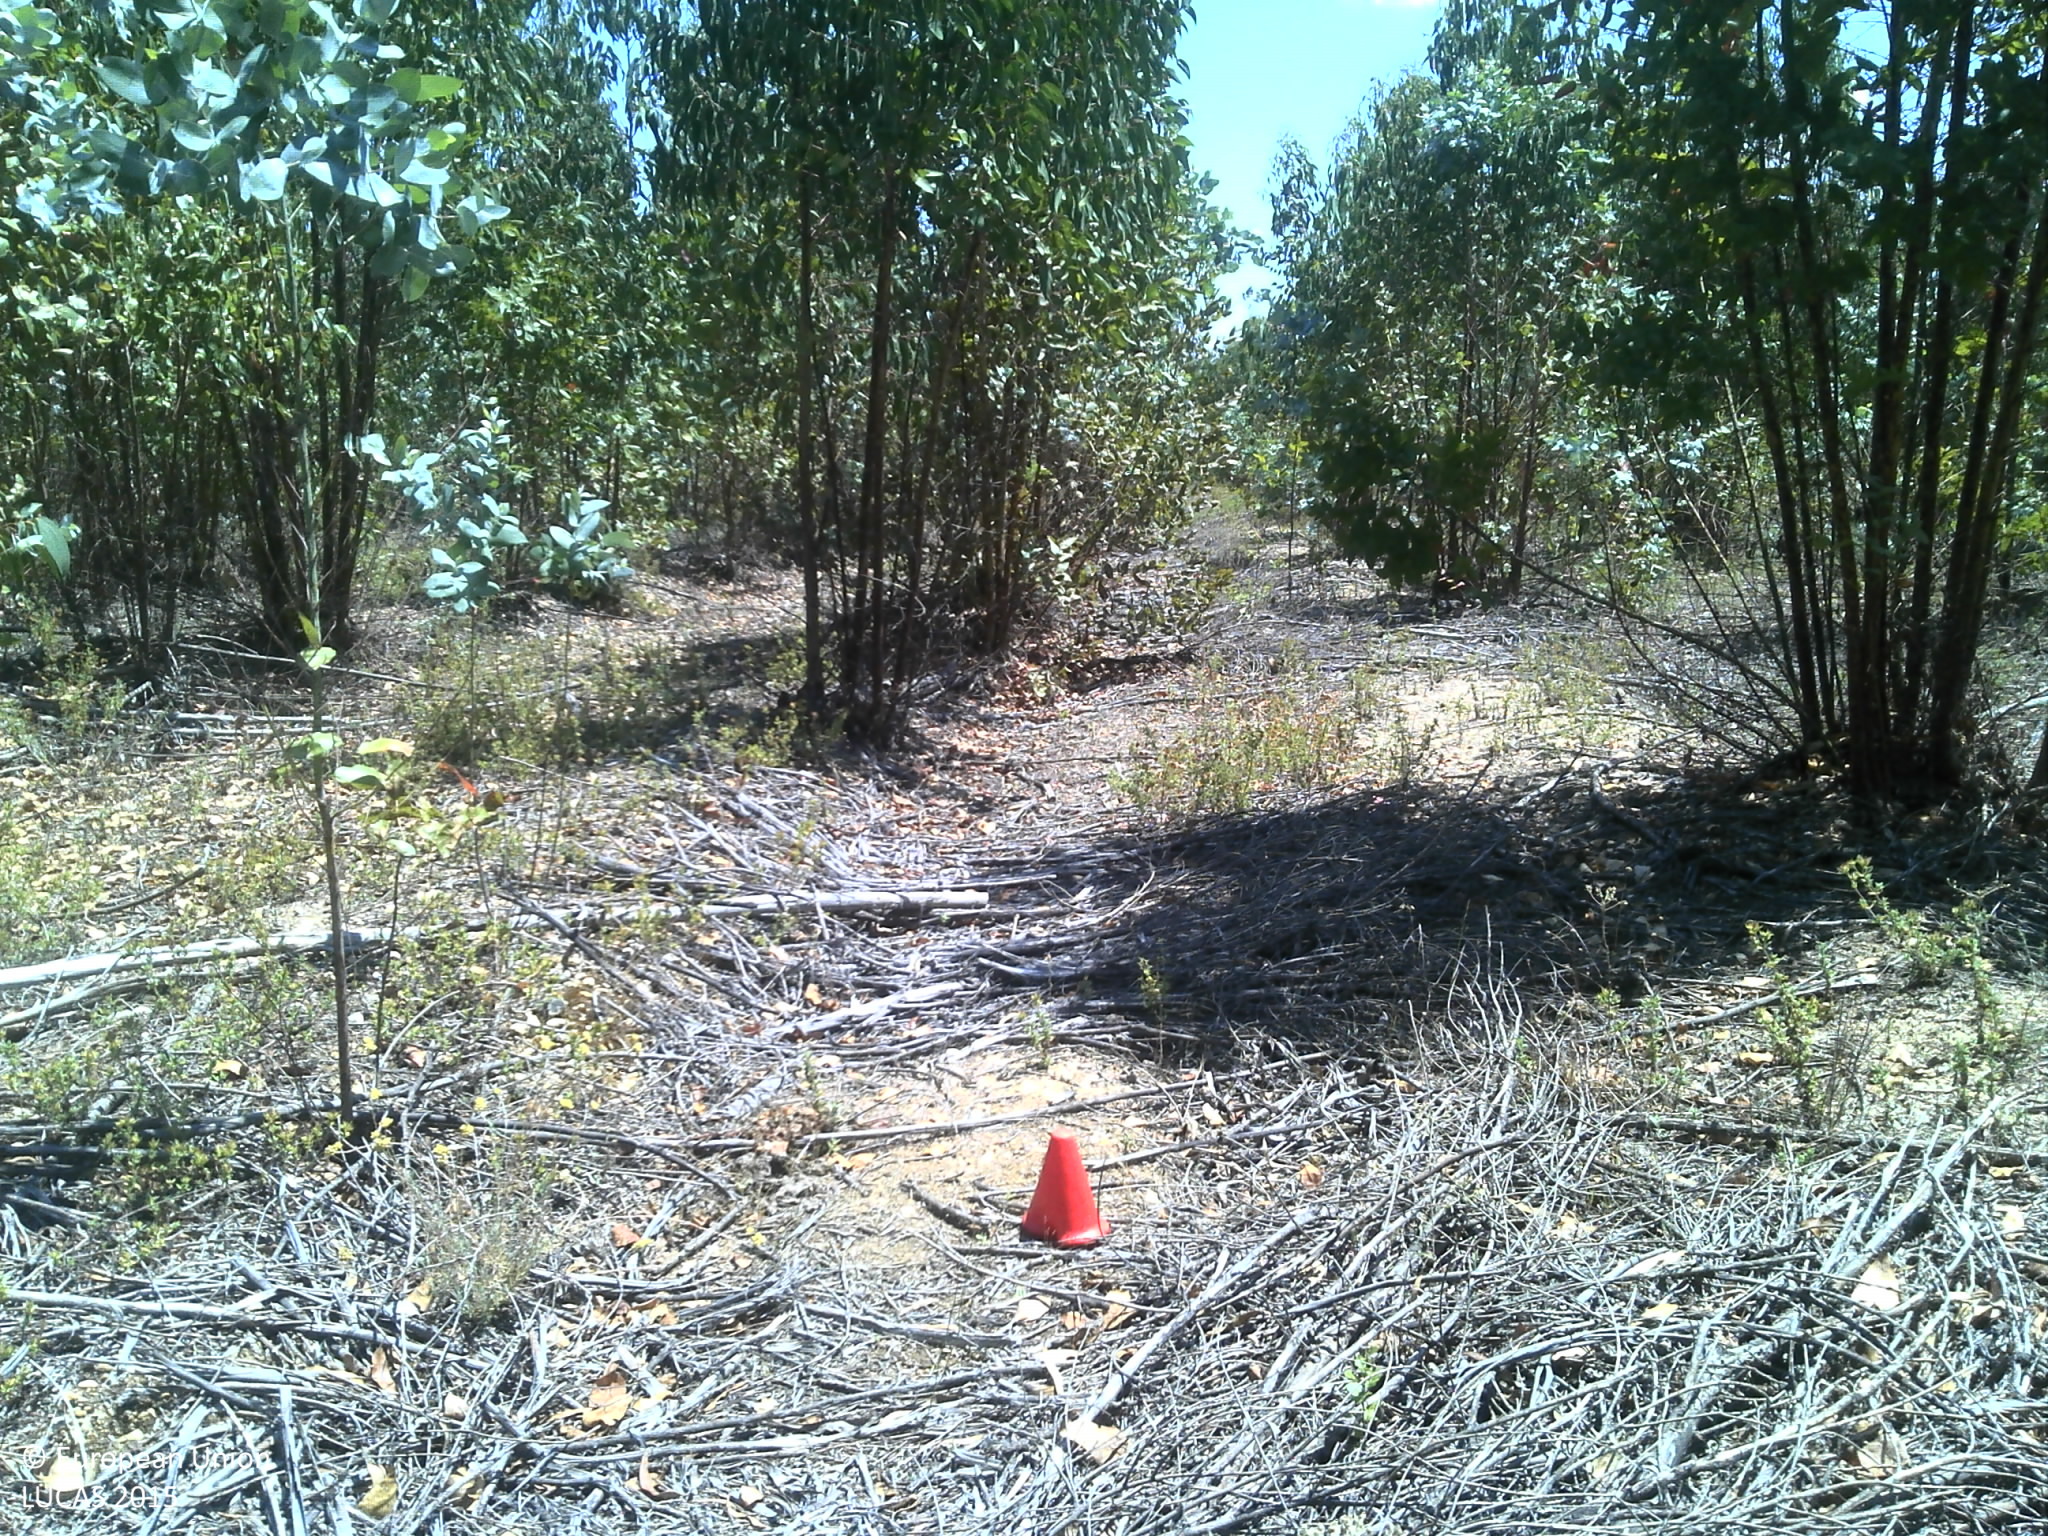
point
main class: Woodland
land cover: Broadleaved woodland
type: exotic forest
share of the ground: 50 - 75 %
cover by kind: broadleaved forest trees 75 %, shrubs 15 %, unconsolidated bare surface 10 %
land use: Forestry
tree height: > 5 m
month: June
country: PT
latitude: 39.2878
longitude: -8.3001
